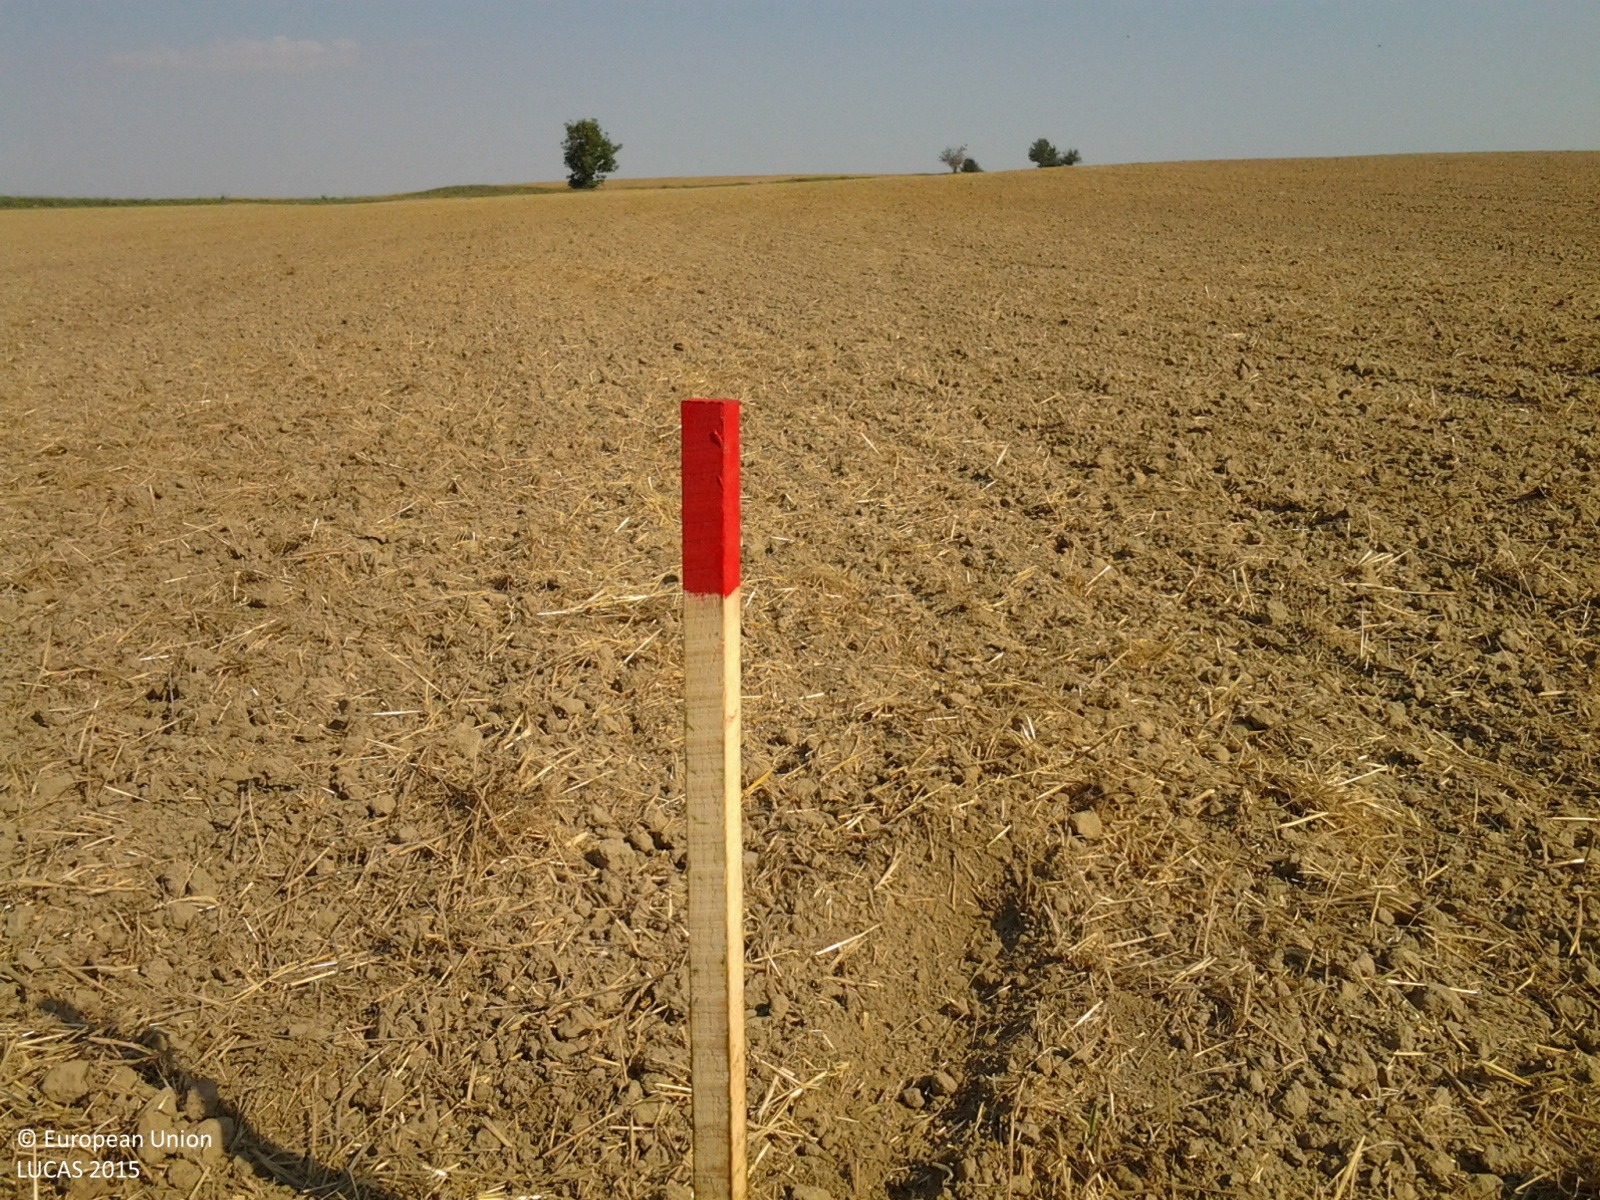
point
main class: Cropland
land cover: Oats
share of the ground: < 10 %
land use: Agriculture (excluding fallow land and kitchen gardens)
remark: Harvested field
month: August
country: HU
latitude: 46.6054
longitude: 17.0664
